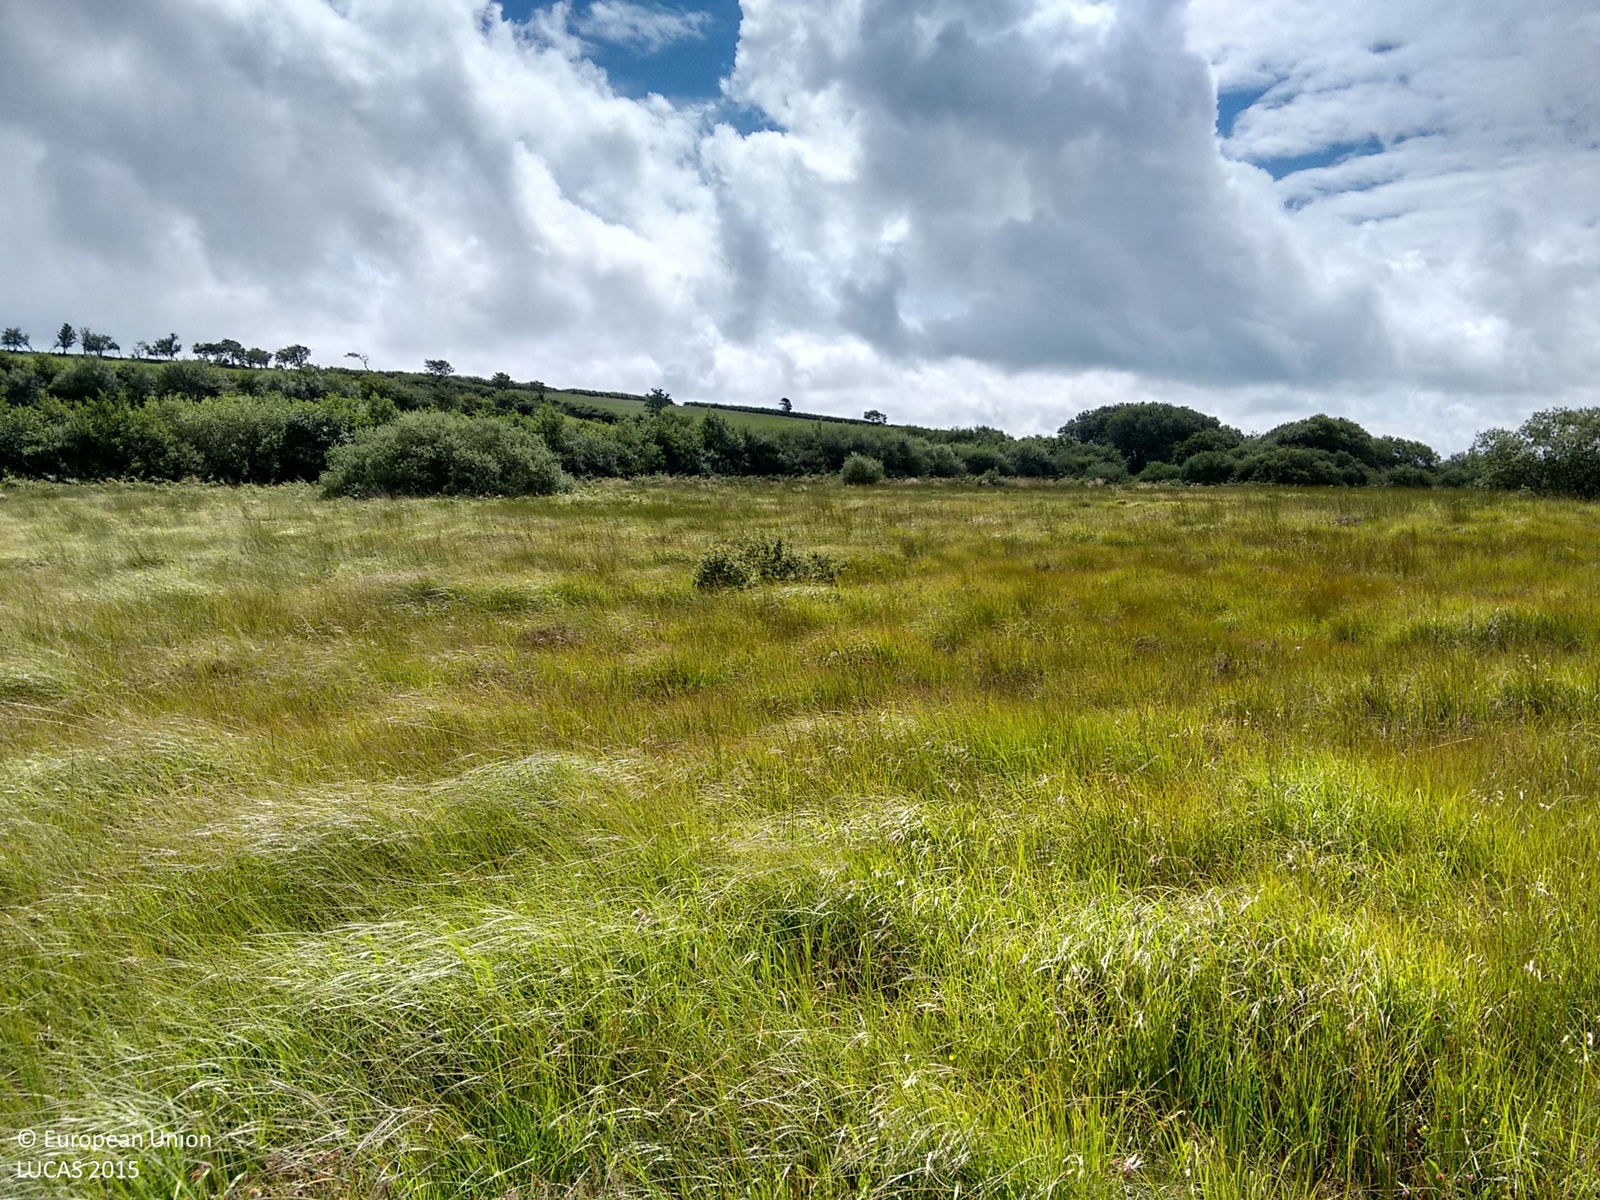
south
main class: Grassland
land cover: Grassland without tree/shrub cover
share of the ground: > 75 %
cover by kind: herbaceous plants 100 %
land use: Agriculture (excluding fallow land and kitchen gardens)
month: August
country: GB
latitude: 51.9527
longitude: -4.0793
